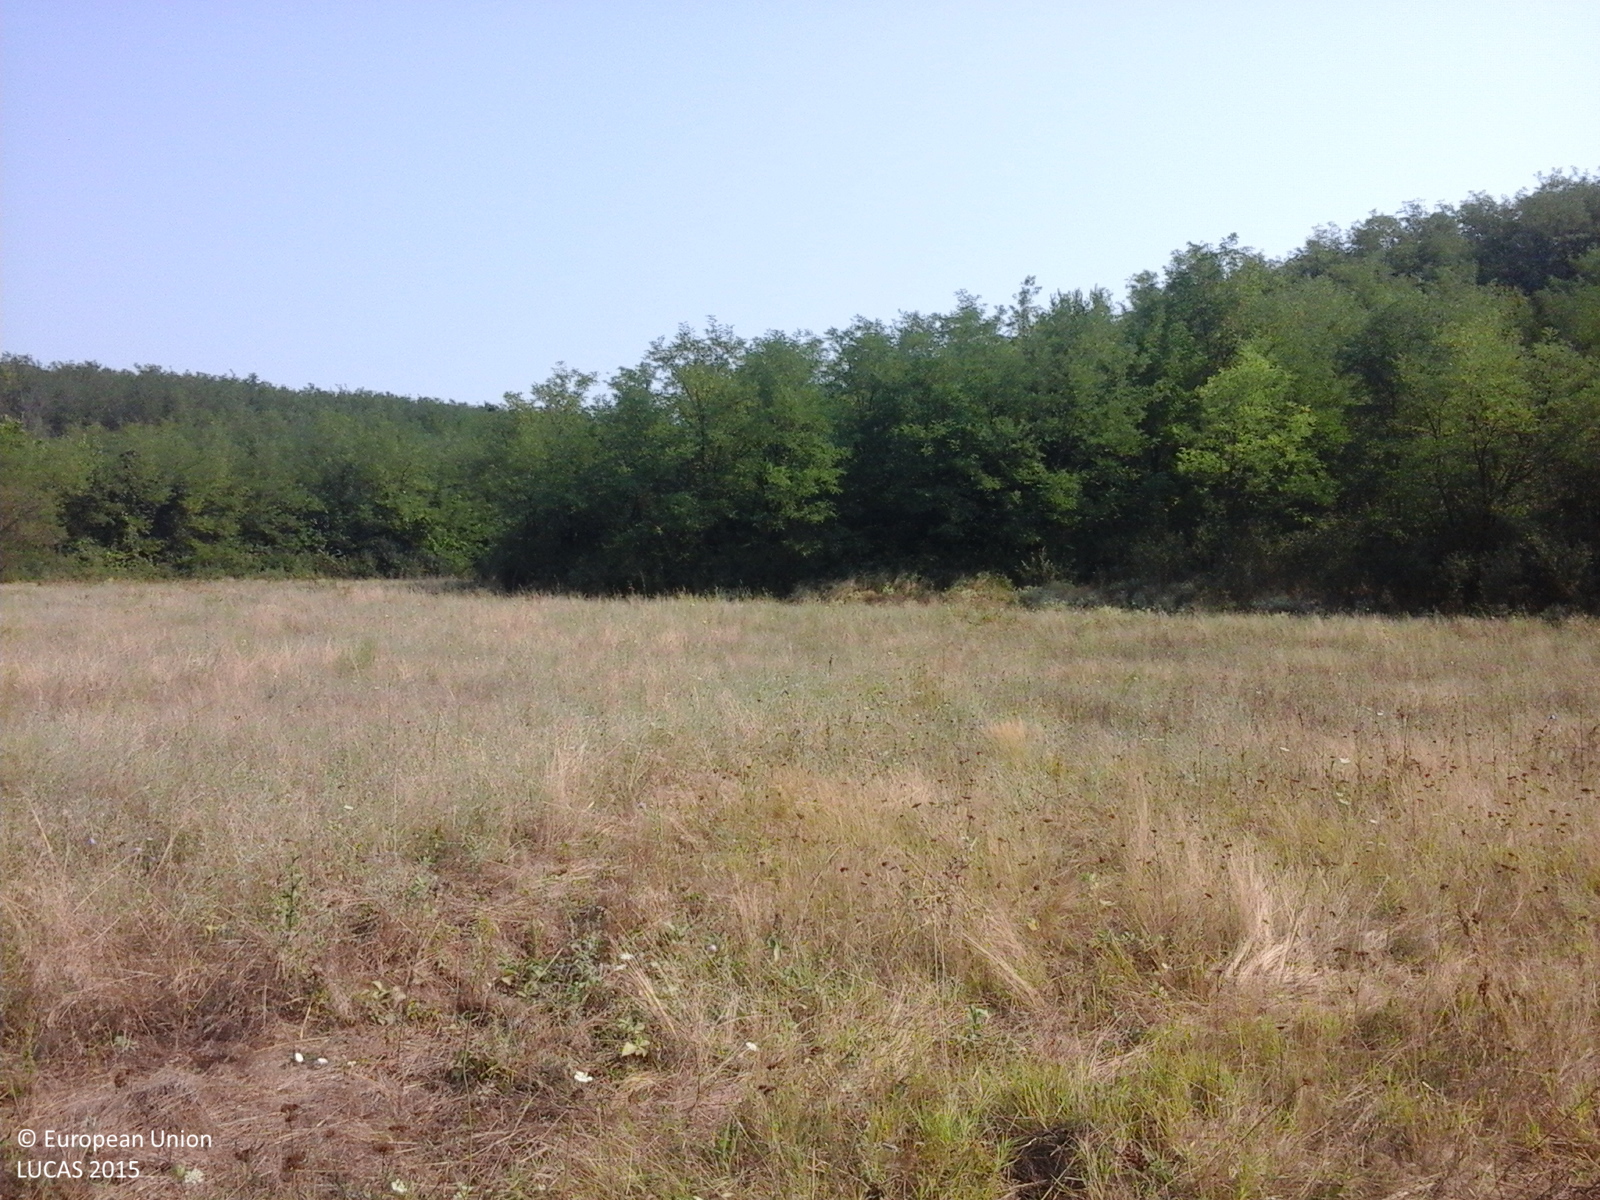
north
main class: Grassland
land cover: Grassland without tree/shrub cover
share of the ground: > 75 %
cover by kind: herbaceous plants 100 %
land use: Agriculture (excluding fallow land and kitchen gardens)
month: August
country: RO
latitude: 44.4852
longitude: 23.0857
